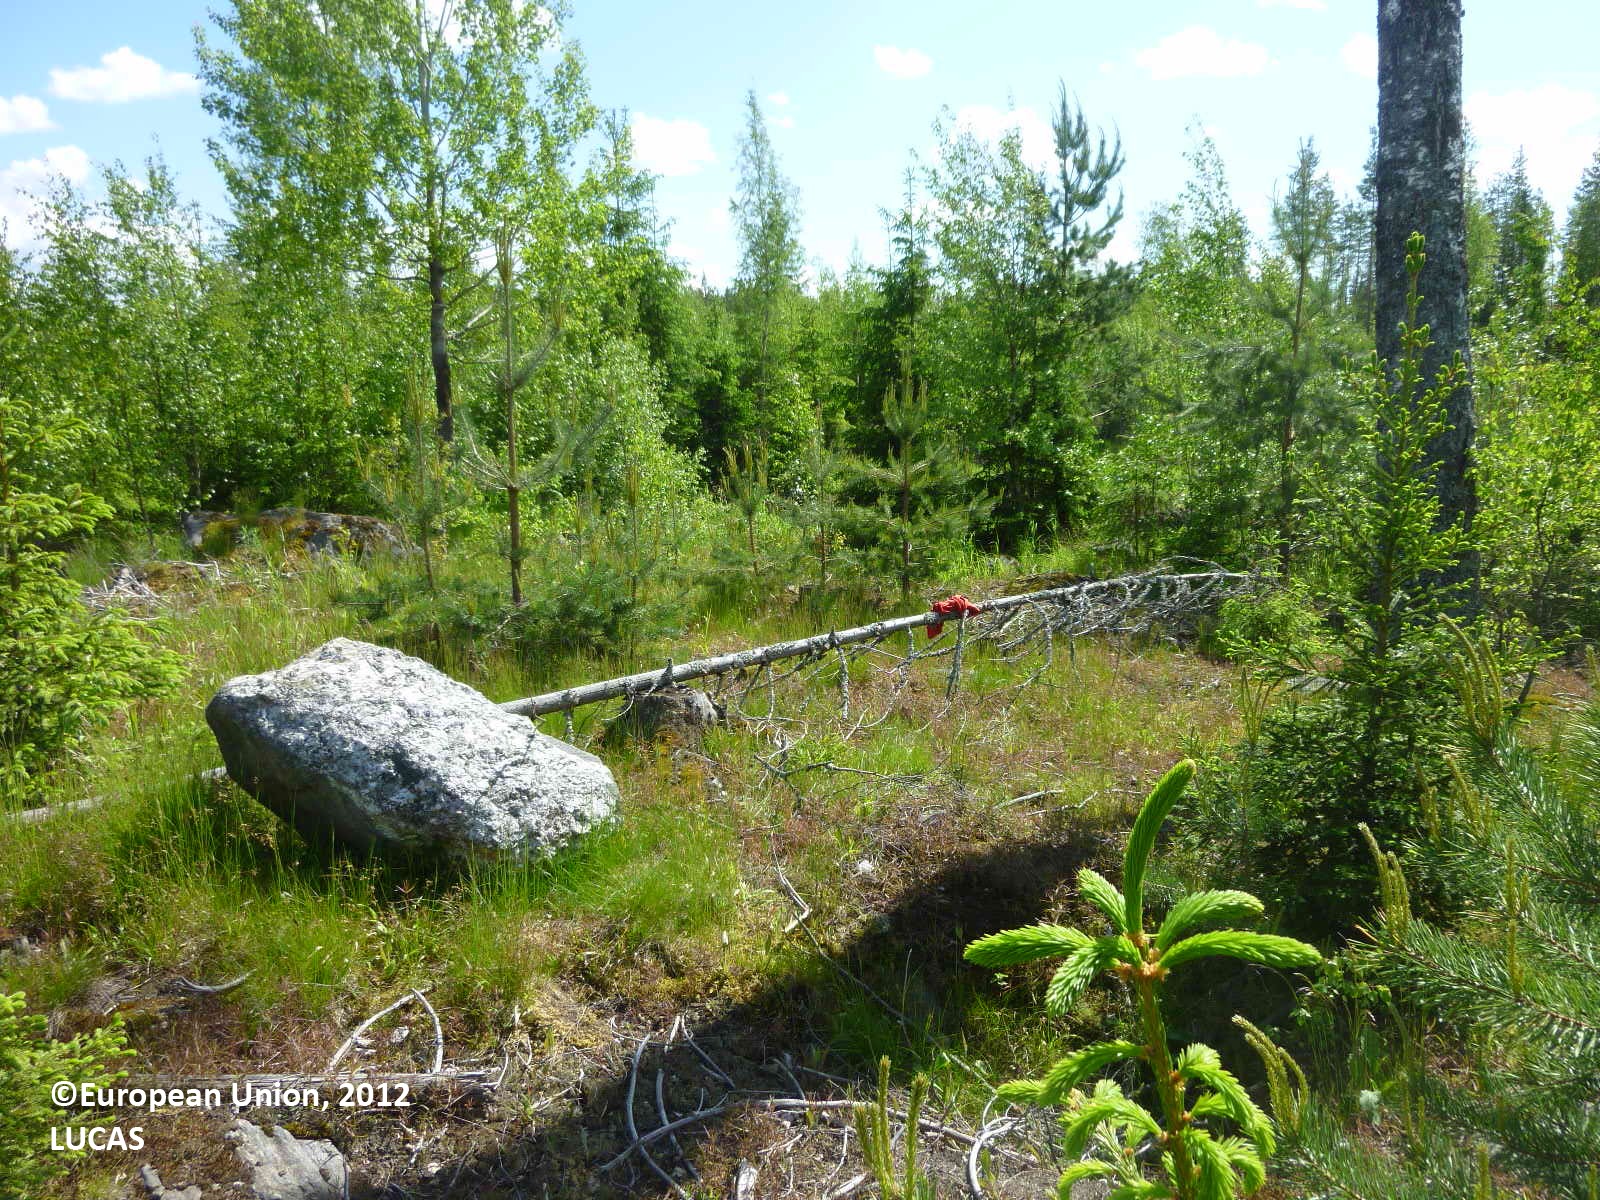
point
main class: Woodland
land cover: Broadleaved woodland
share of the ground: 25 - 50 %
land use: Forestry
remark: Clear cut
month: June
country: FI
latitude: 61.4507
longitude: 22.6901
